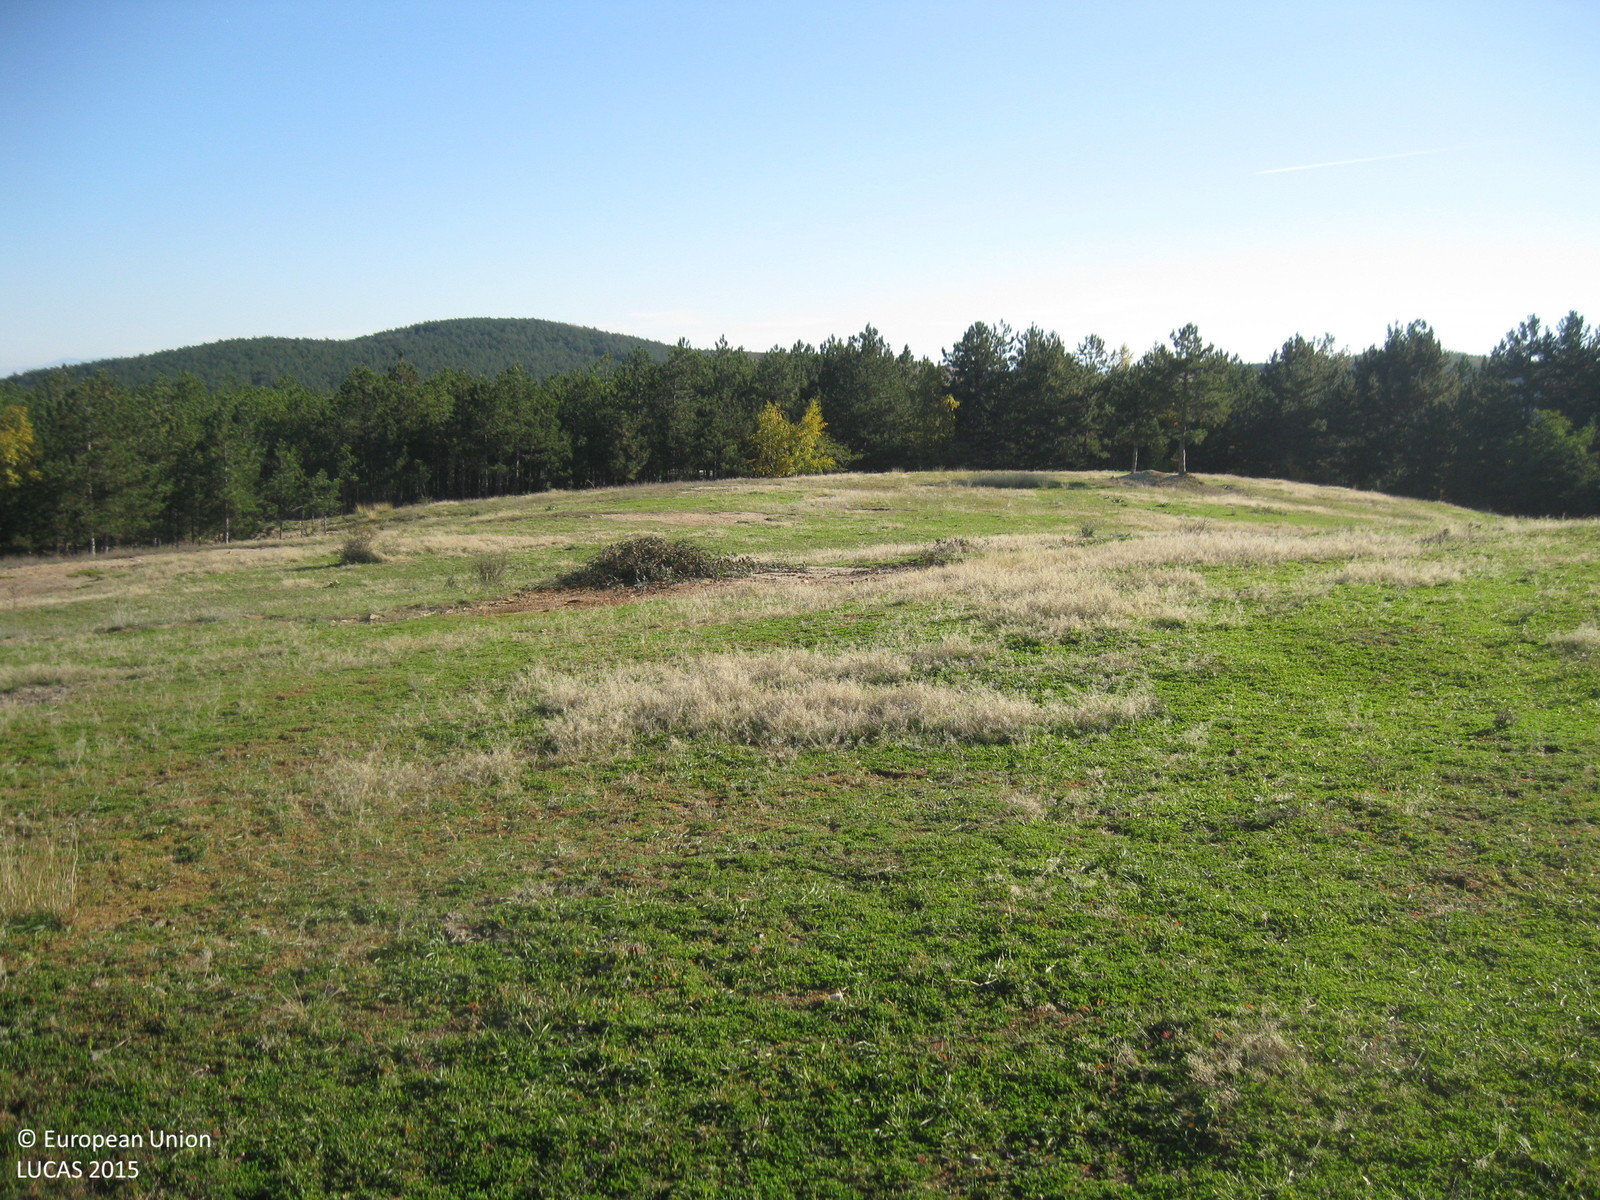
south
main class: Grassland
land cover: Grassland without tree/shrub cover
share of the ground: > 75 %
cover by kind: herbaceous plants 100 %
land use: Semi-natural and natural areas not in use
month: November
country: BG
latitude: 42.3599
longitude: 24.2137
